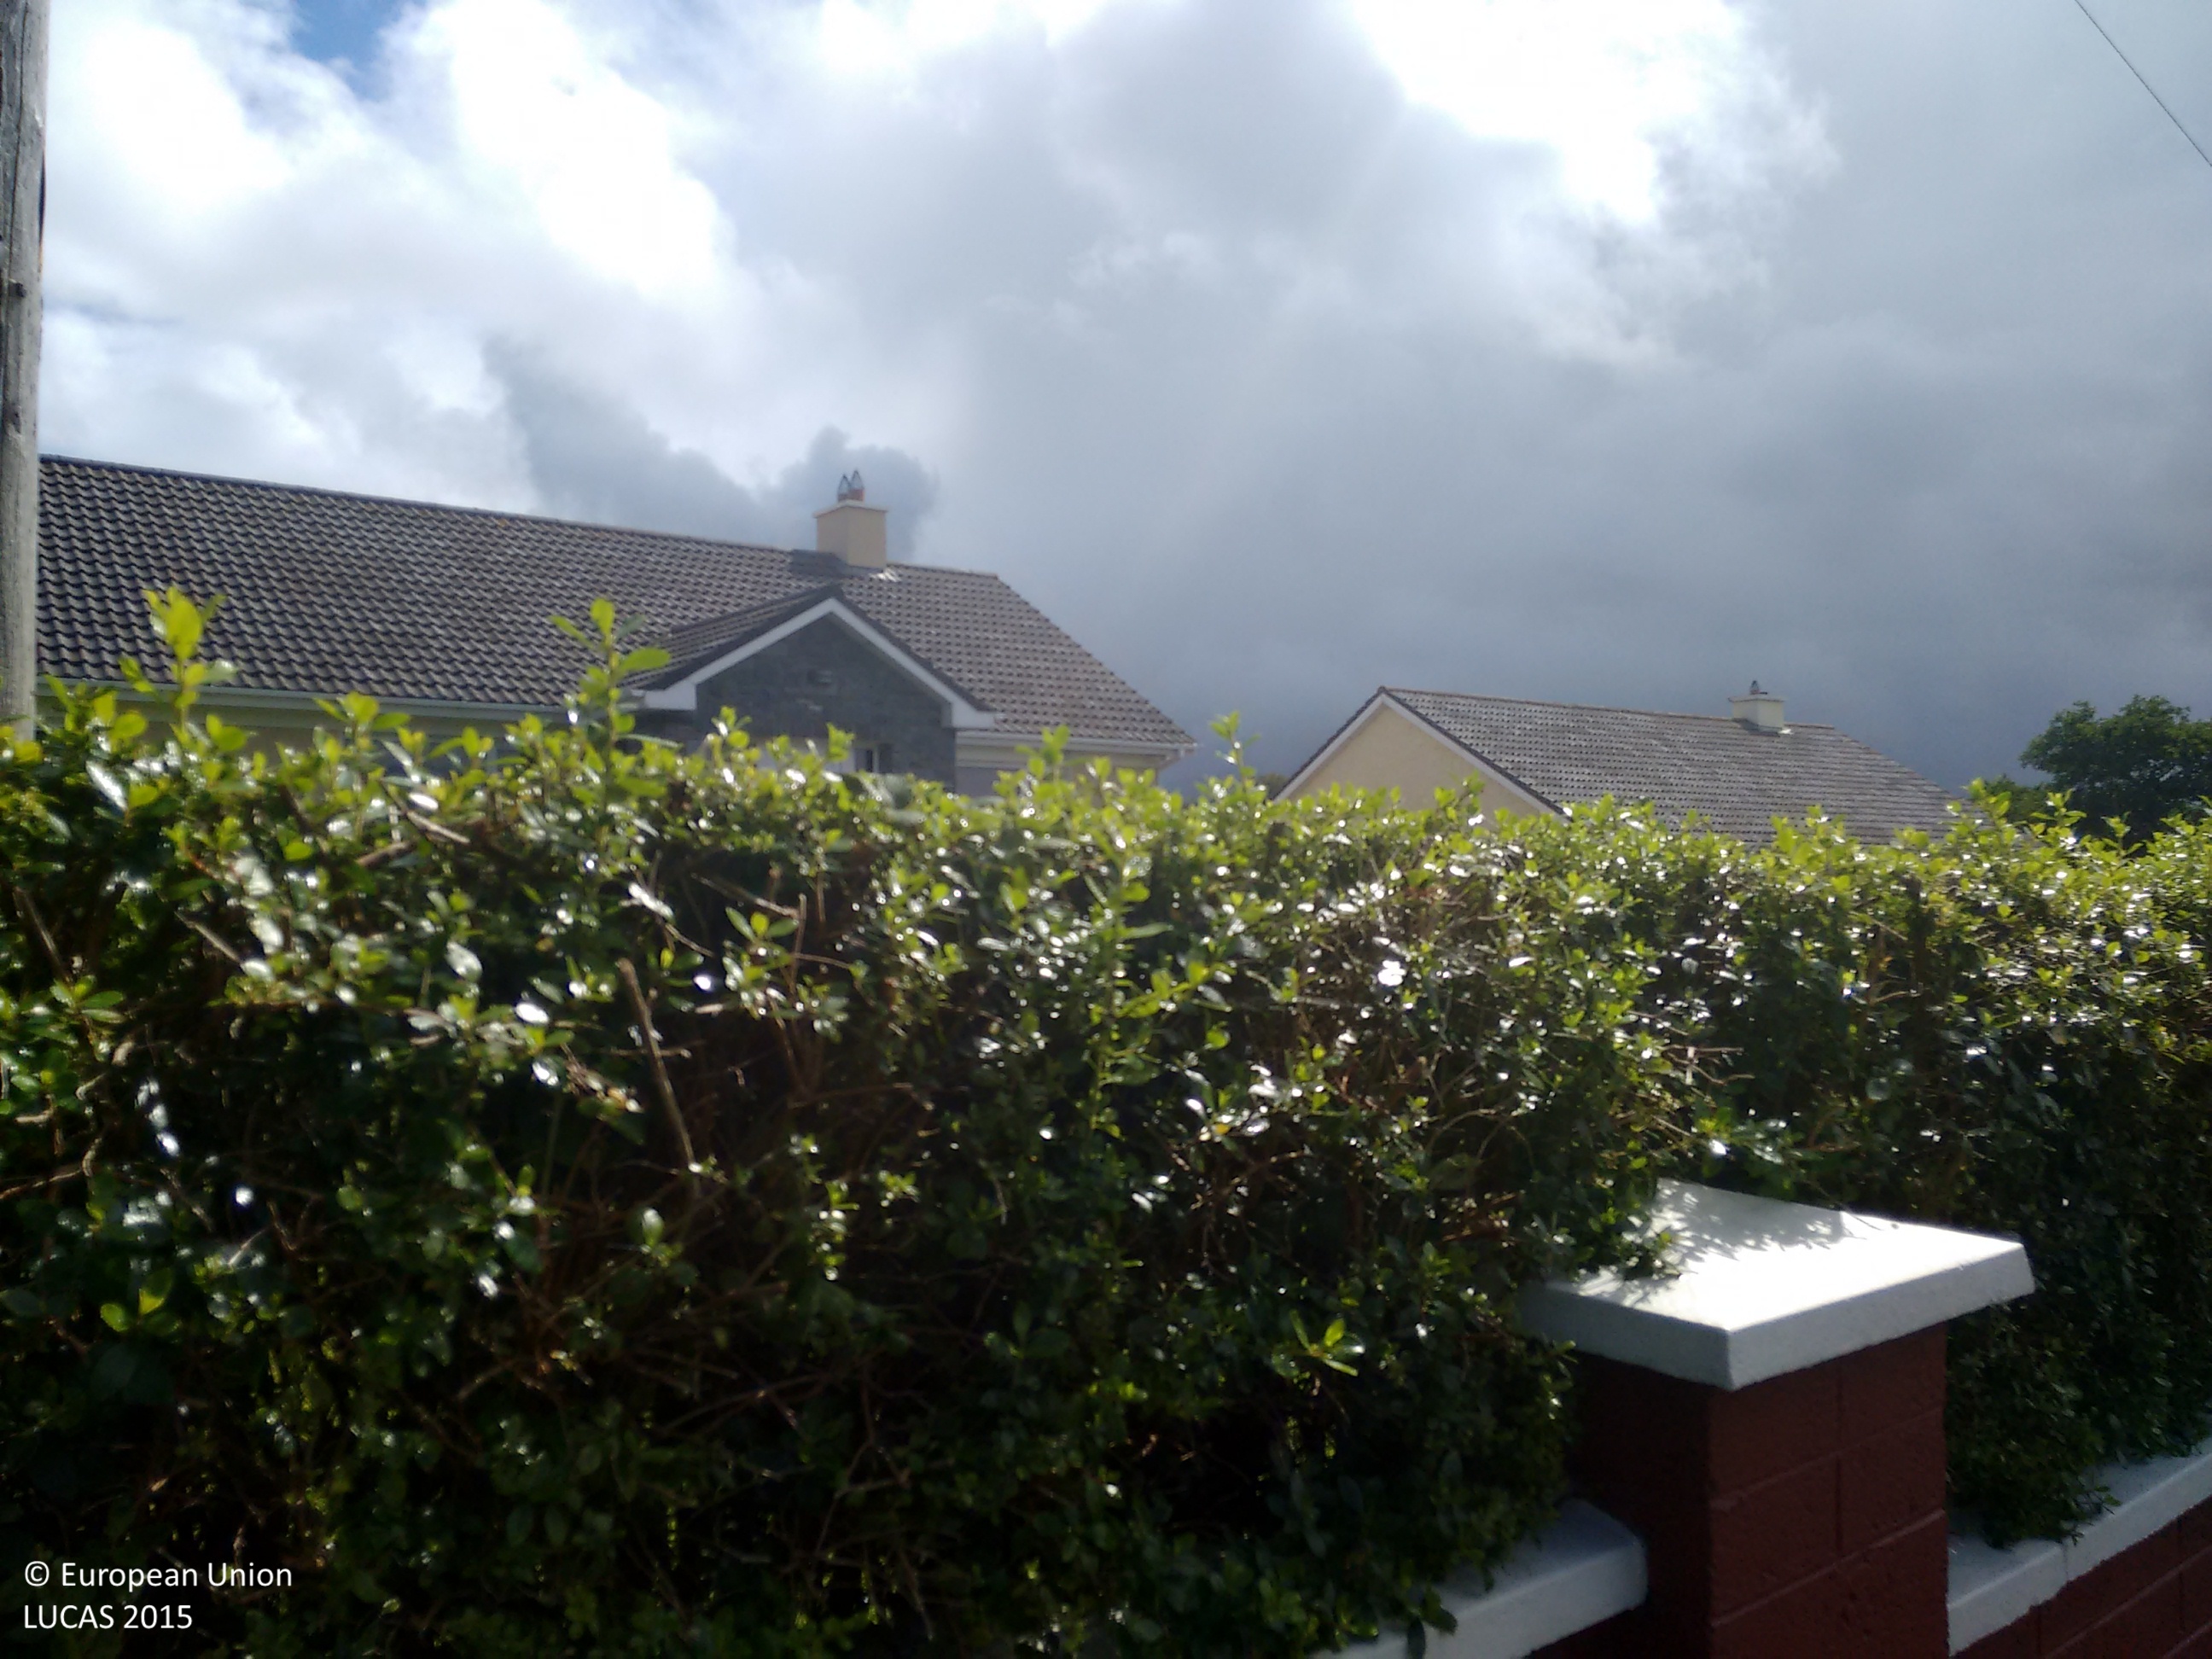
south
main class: Grassland
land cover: Grassland without tree/shrub cover
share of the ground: > 75 %
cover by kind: herbaceous plants 70 %, consolidated bare surface 25 %, shrubs 5 %
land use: Residential
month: August
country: IE
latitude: 52.0955
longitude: -9.7904
